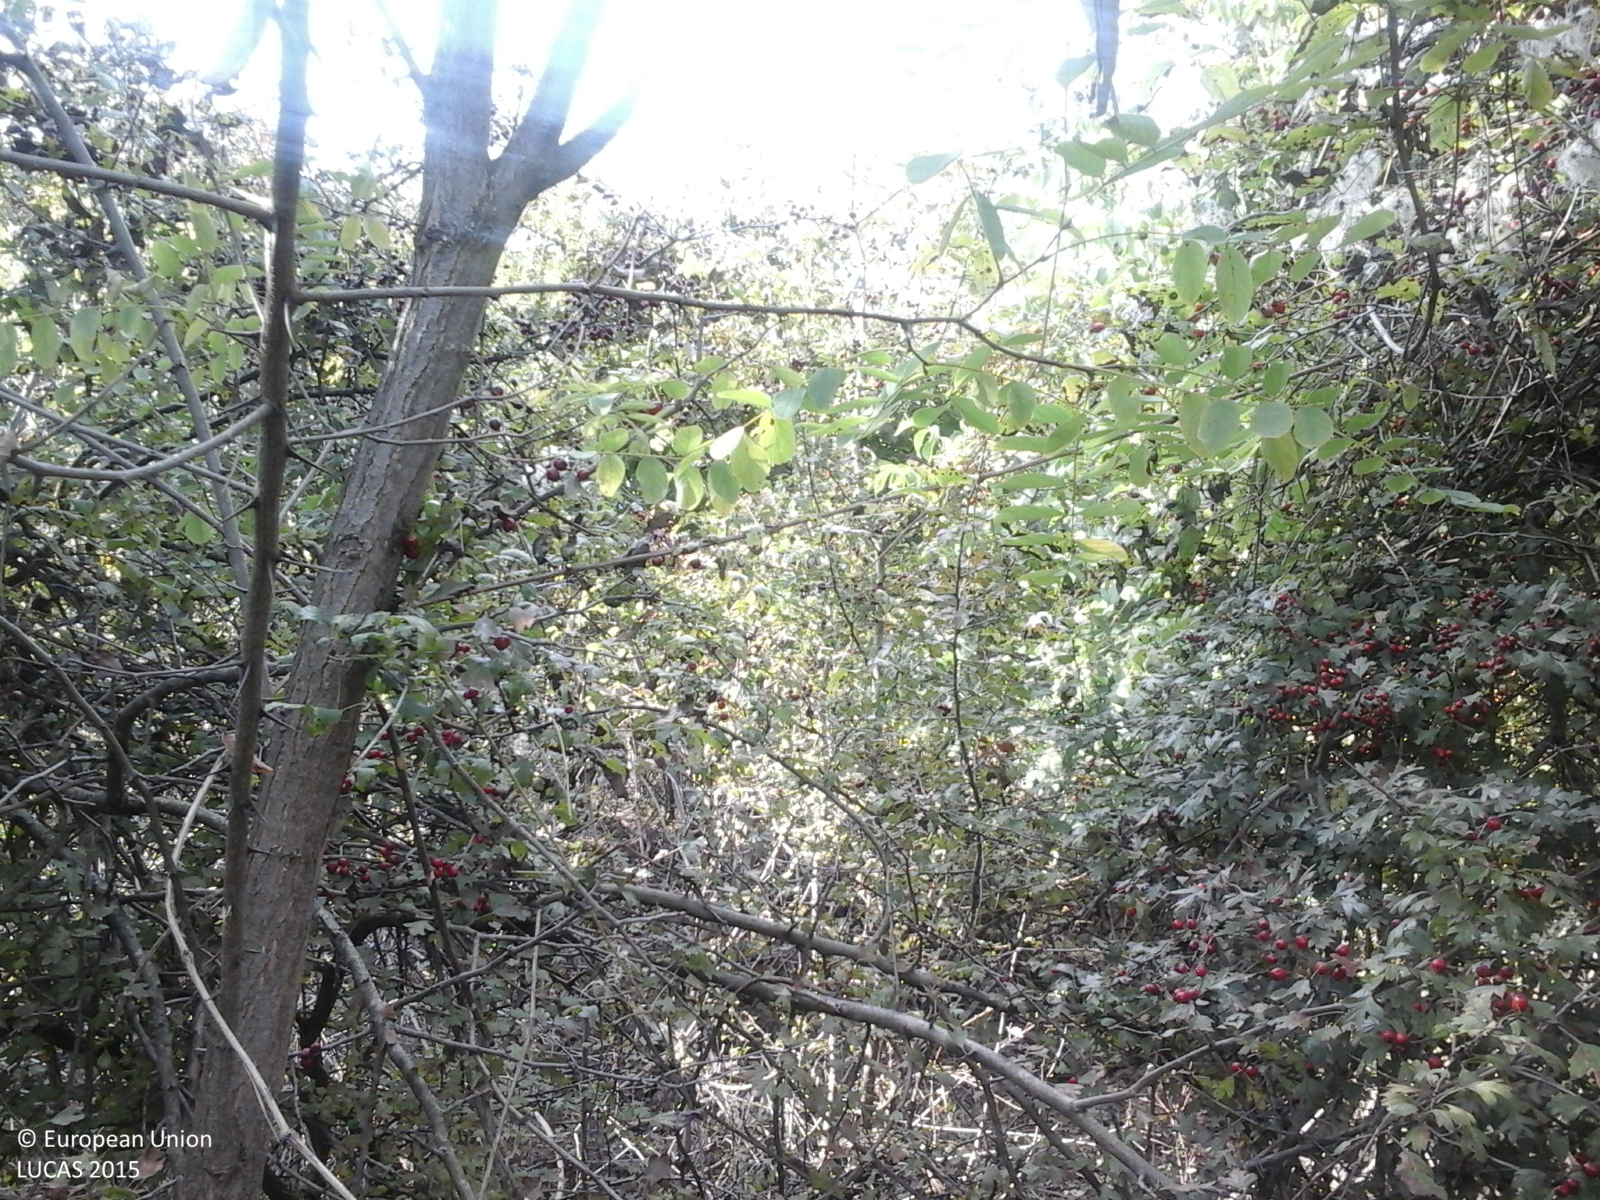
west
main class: Woodland
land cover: Broadleaved woodland
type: exotic forest
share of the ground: > 75 %
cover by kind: broadleaved forest trees 100 %
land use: Forestry
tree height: > 5 m
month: October
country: RO
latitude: 46.4143
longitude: 24.1162
